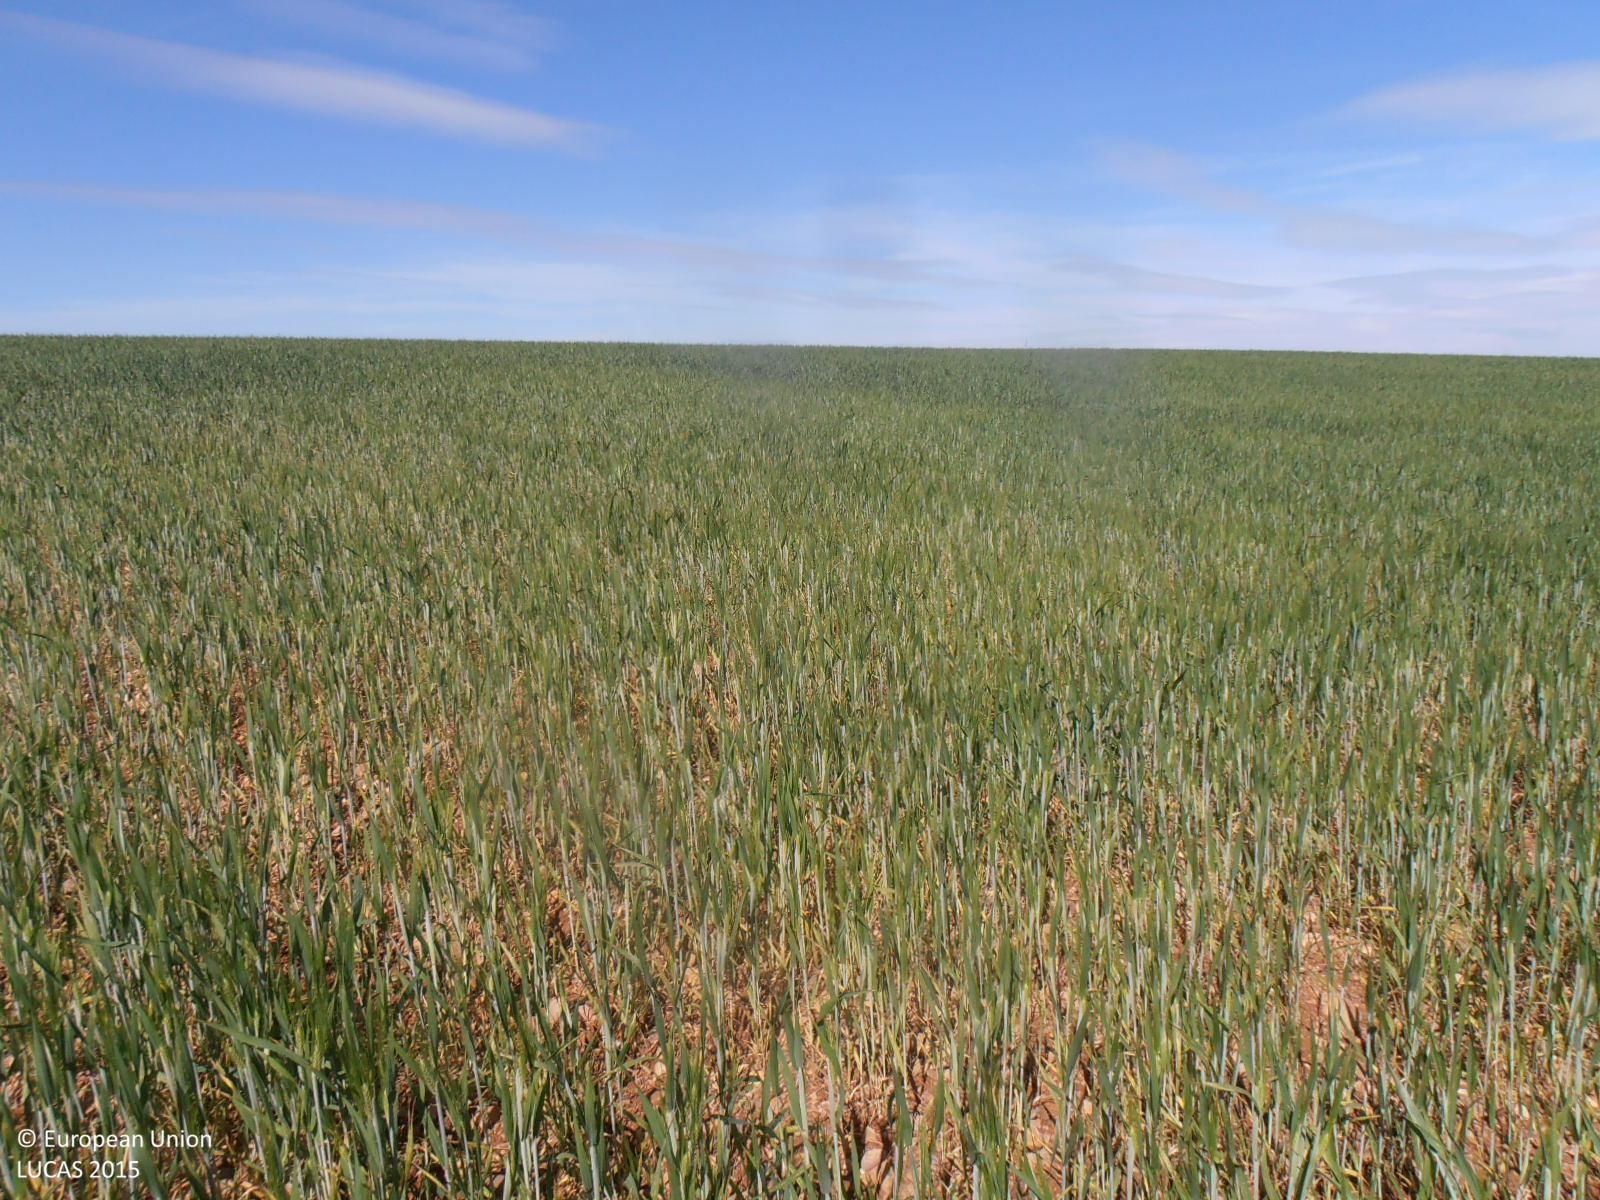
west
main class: Cropland
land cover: Durum wheat
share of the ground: > 75 %
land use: Agriculture (excluding fallow land and kitchen gardens)
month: April
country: ES
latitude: 41.3086
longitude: -1.1408
